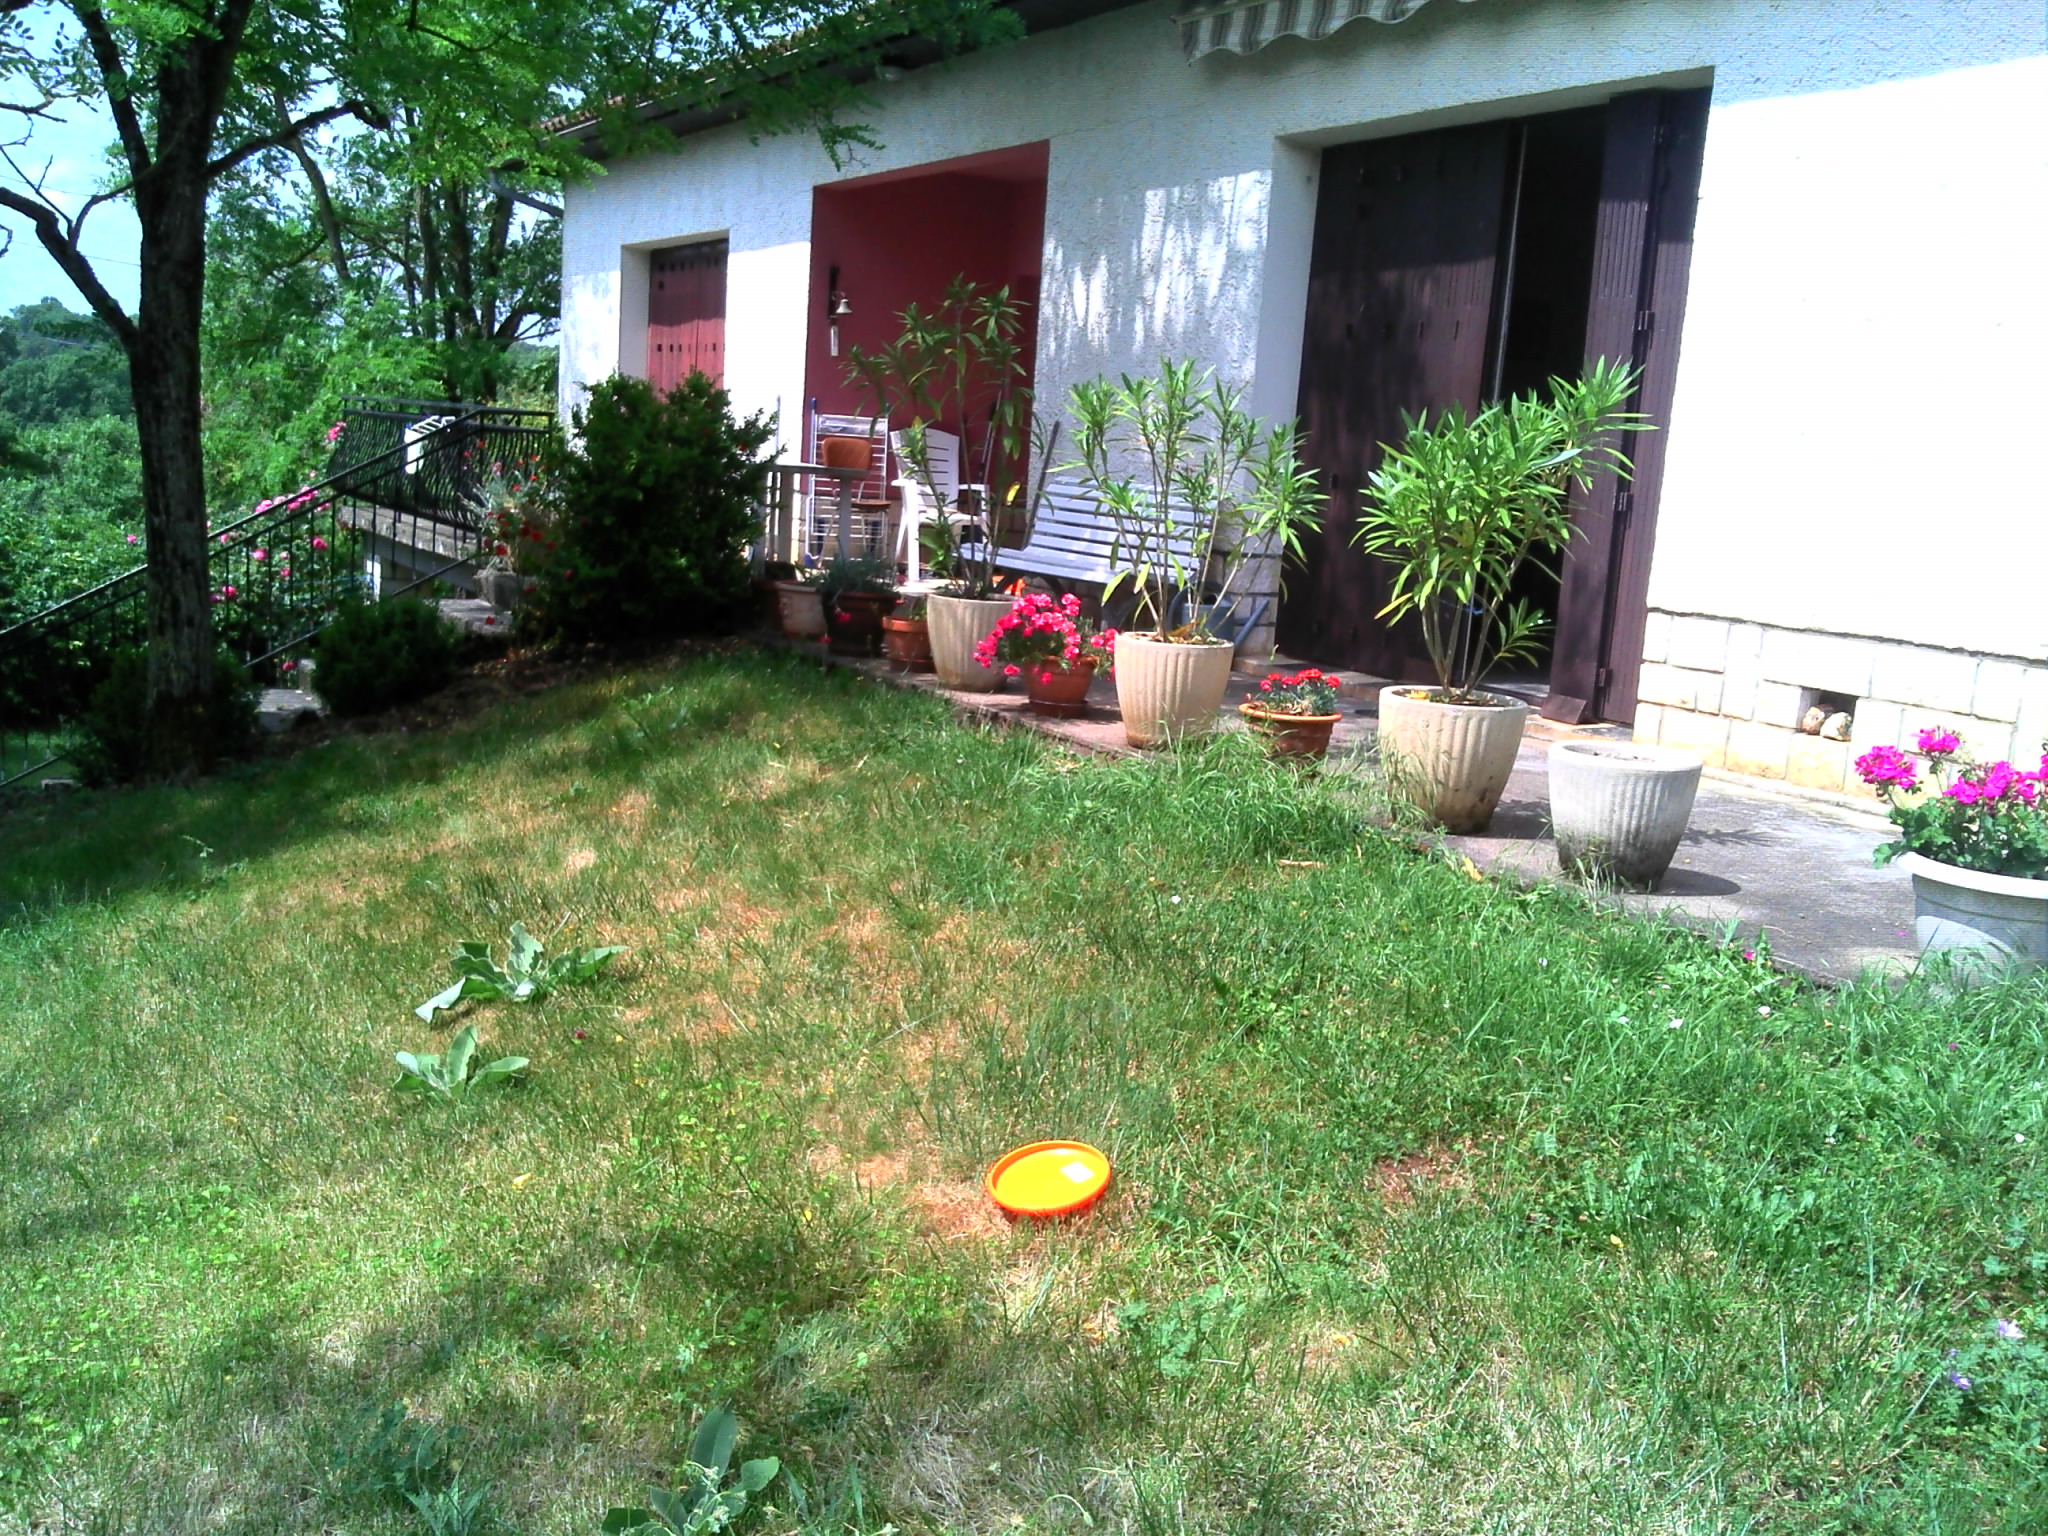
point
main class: Grassland
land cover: Grassland without tree/shrub cover
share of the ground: > 75 %
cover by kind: herbaceous plants 100 %
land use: Residential
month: June
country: FR
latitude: 44.6251
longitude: 1.8192
